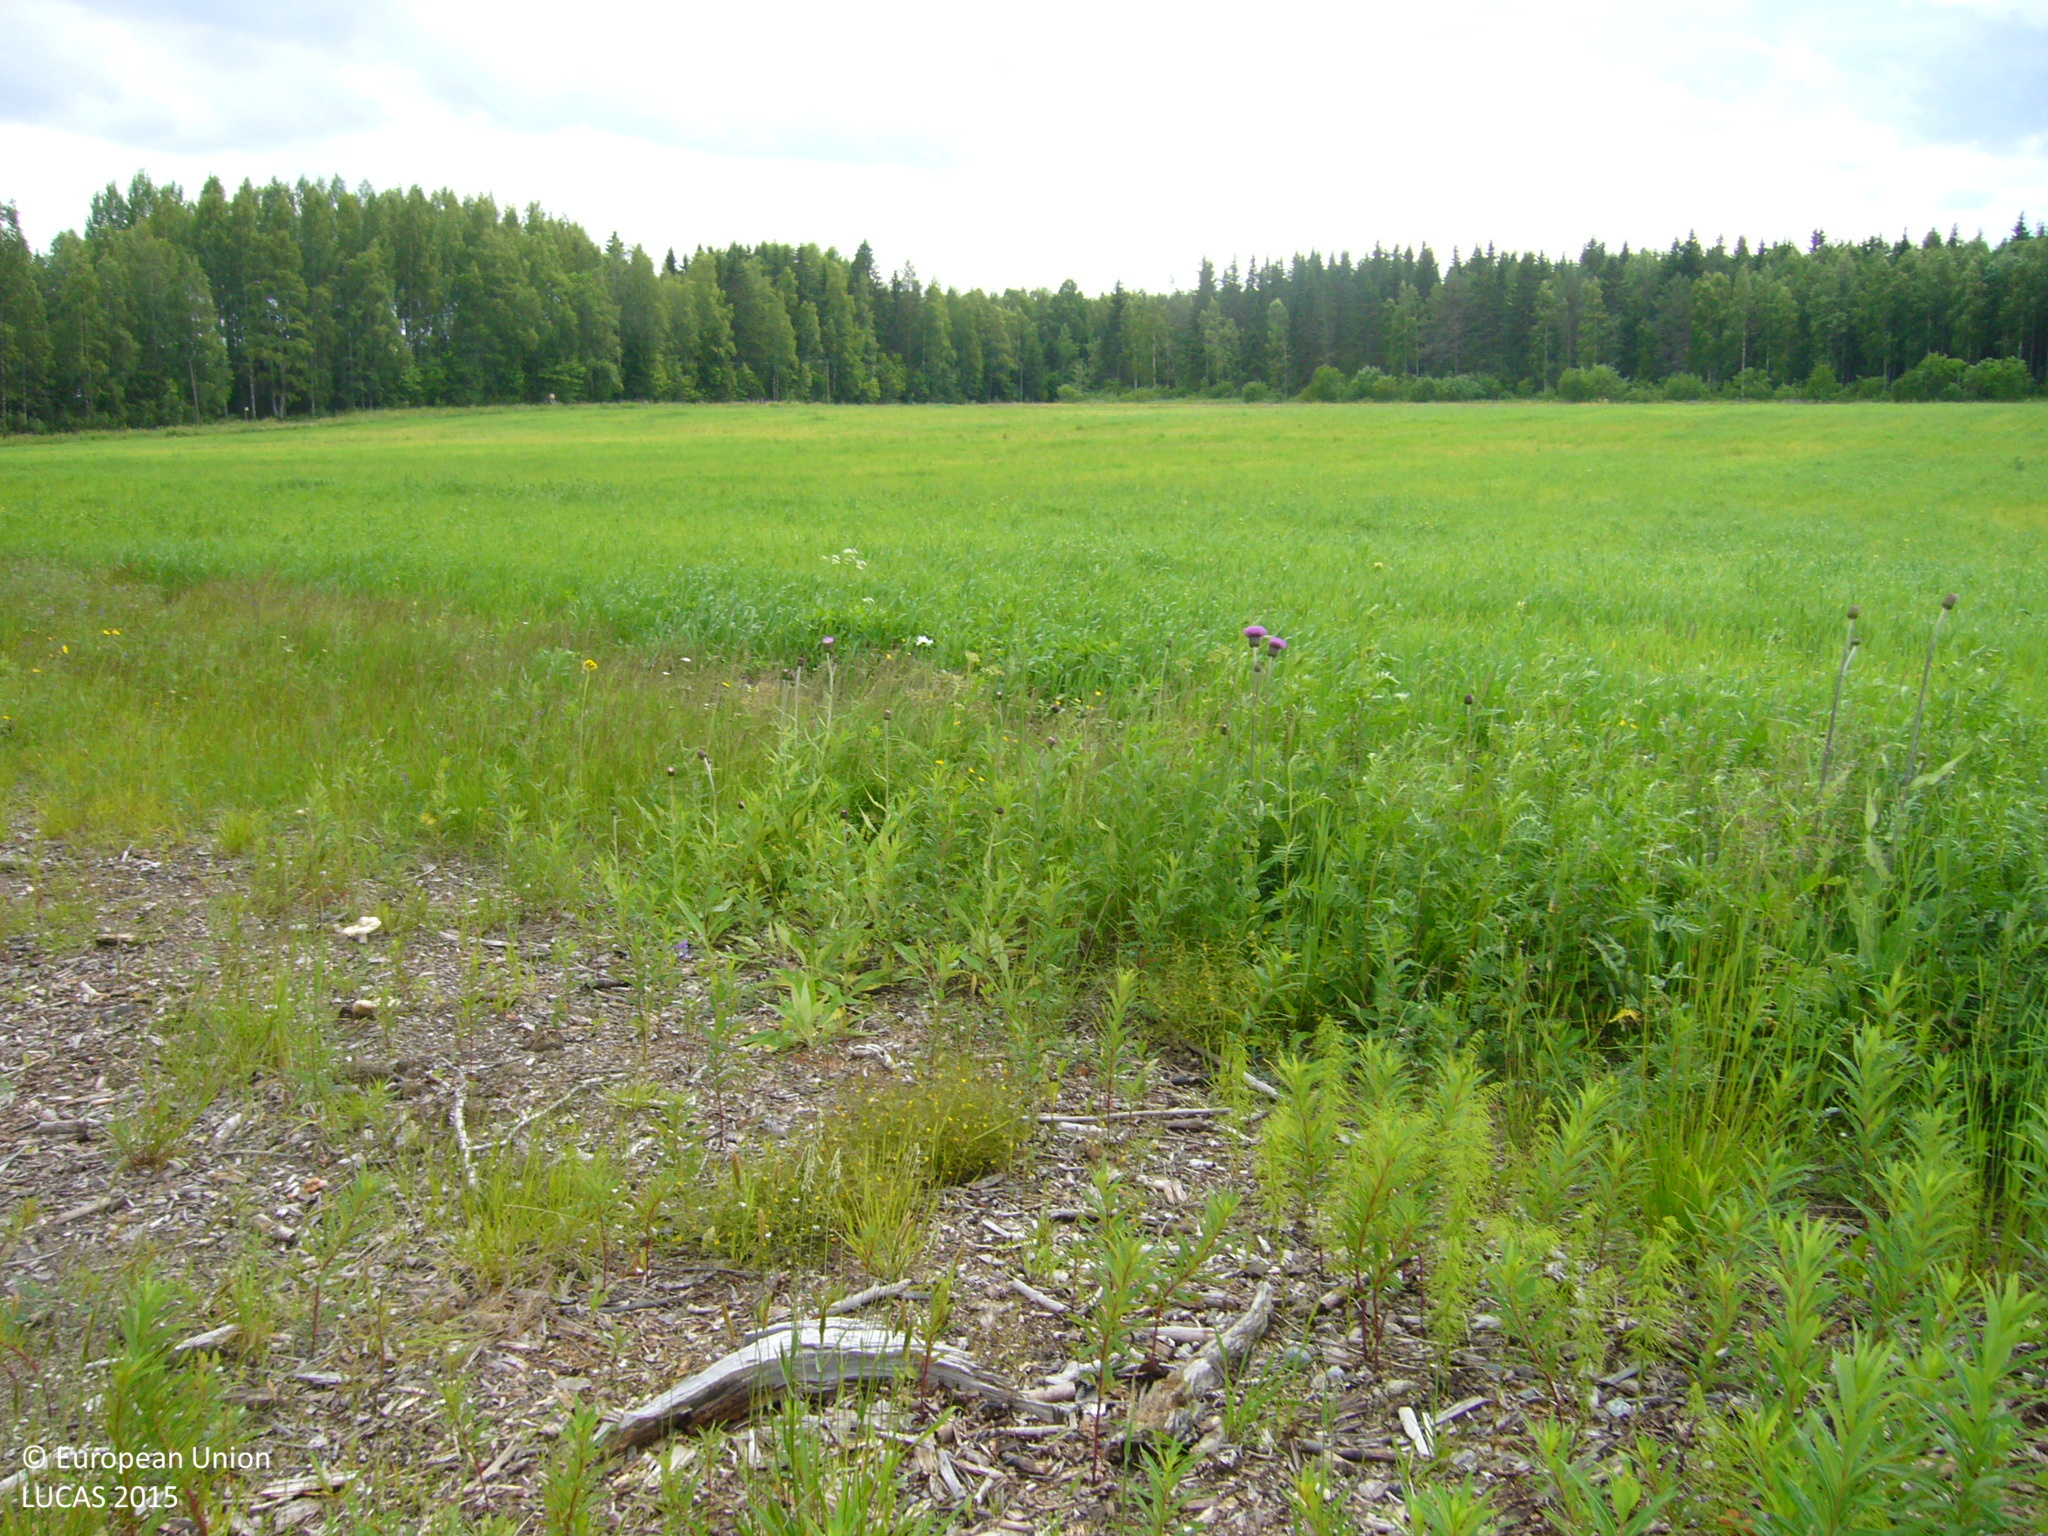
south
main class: Cropland
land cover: Barley
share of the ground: > 75 %
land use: Agriculture (excluding fallow land and kitchen gardens)
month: July
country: FI
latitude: 63.7124
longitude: 25.9565
